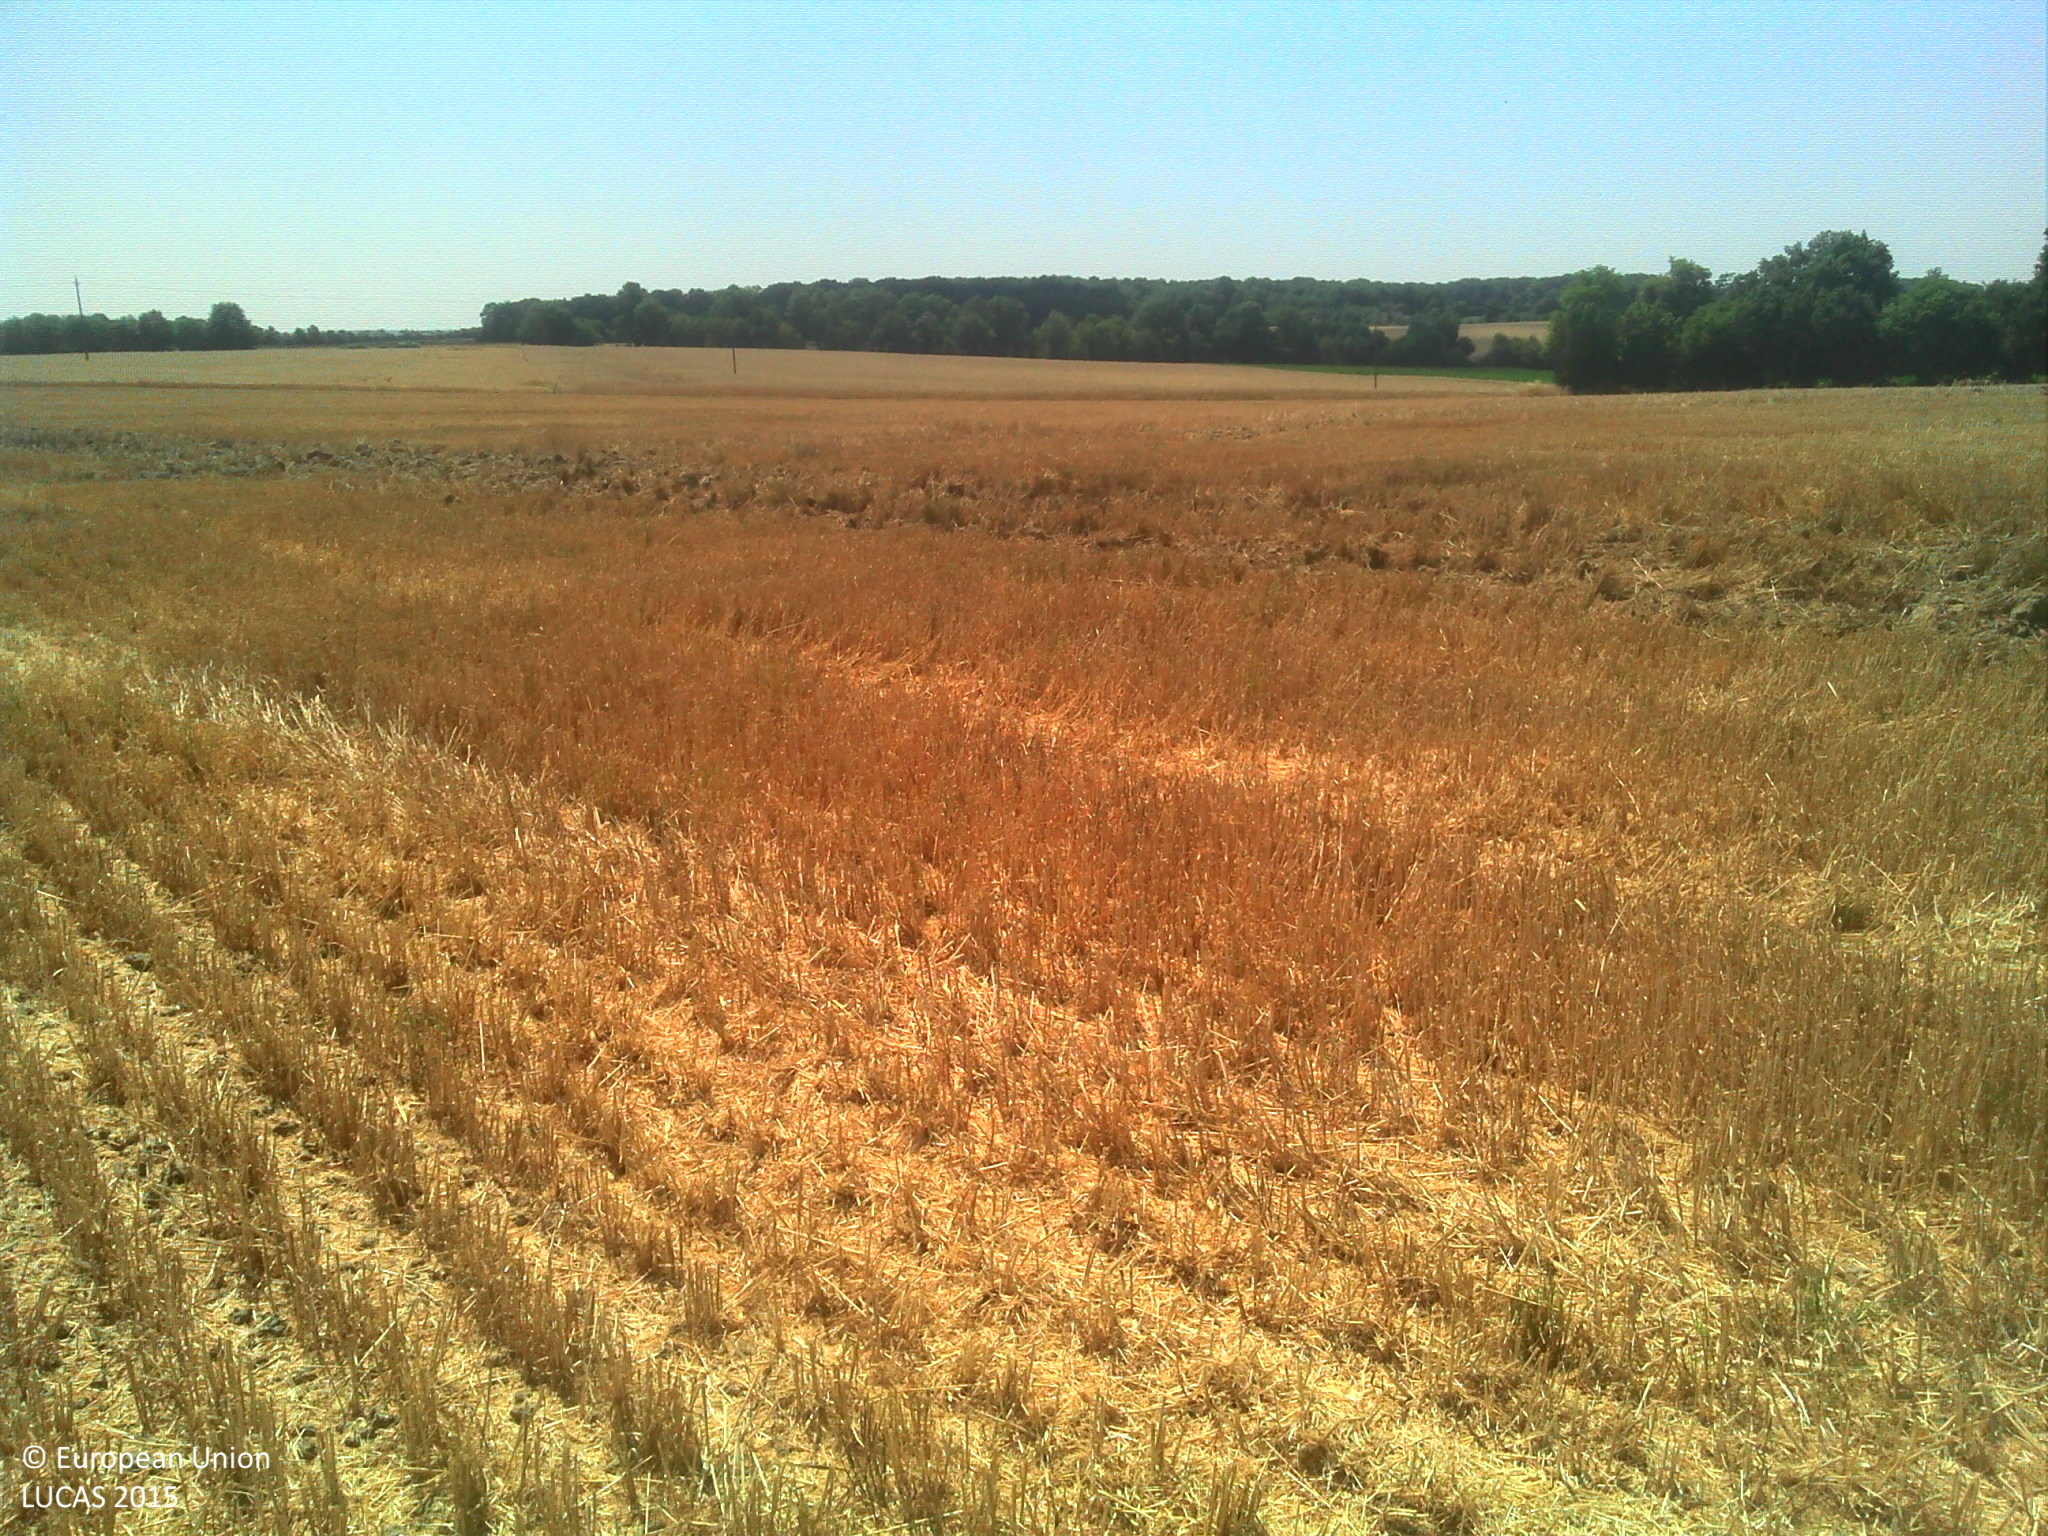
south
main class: Cropland
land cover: Durum wheat
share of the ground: > 75 %
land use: Agriculture (excluding fallow land and kitchen gardens)
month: July
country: FR
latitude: 48.0790
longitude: 0.8653
